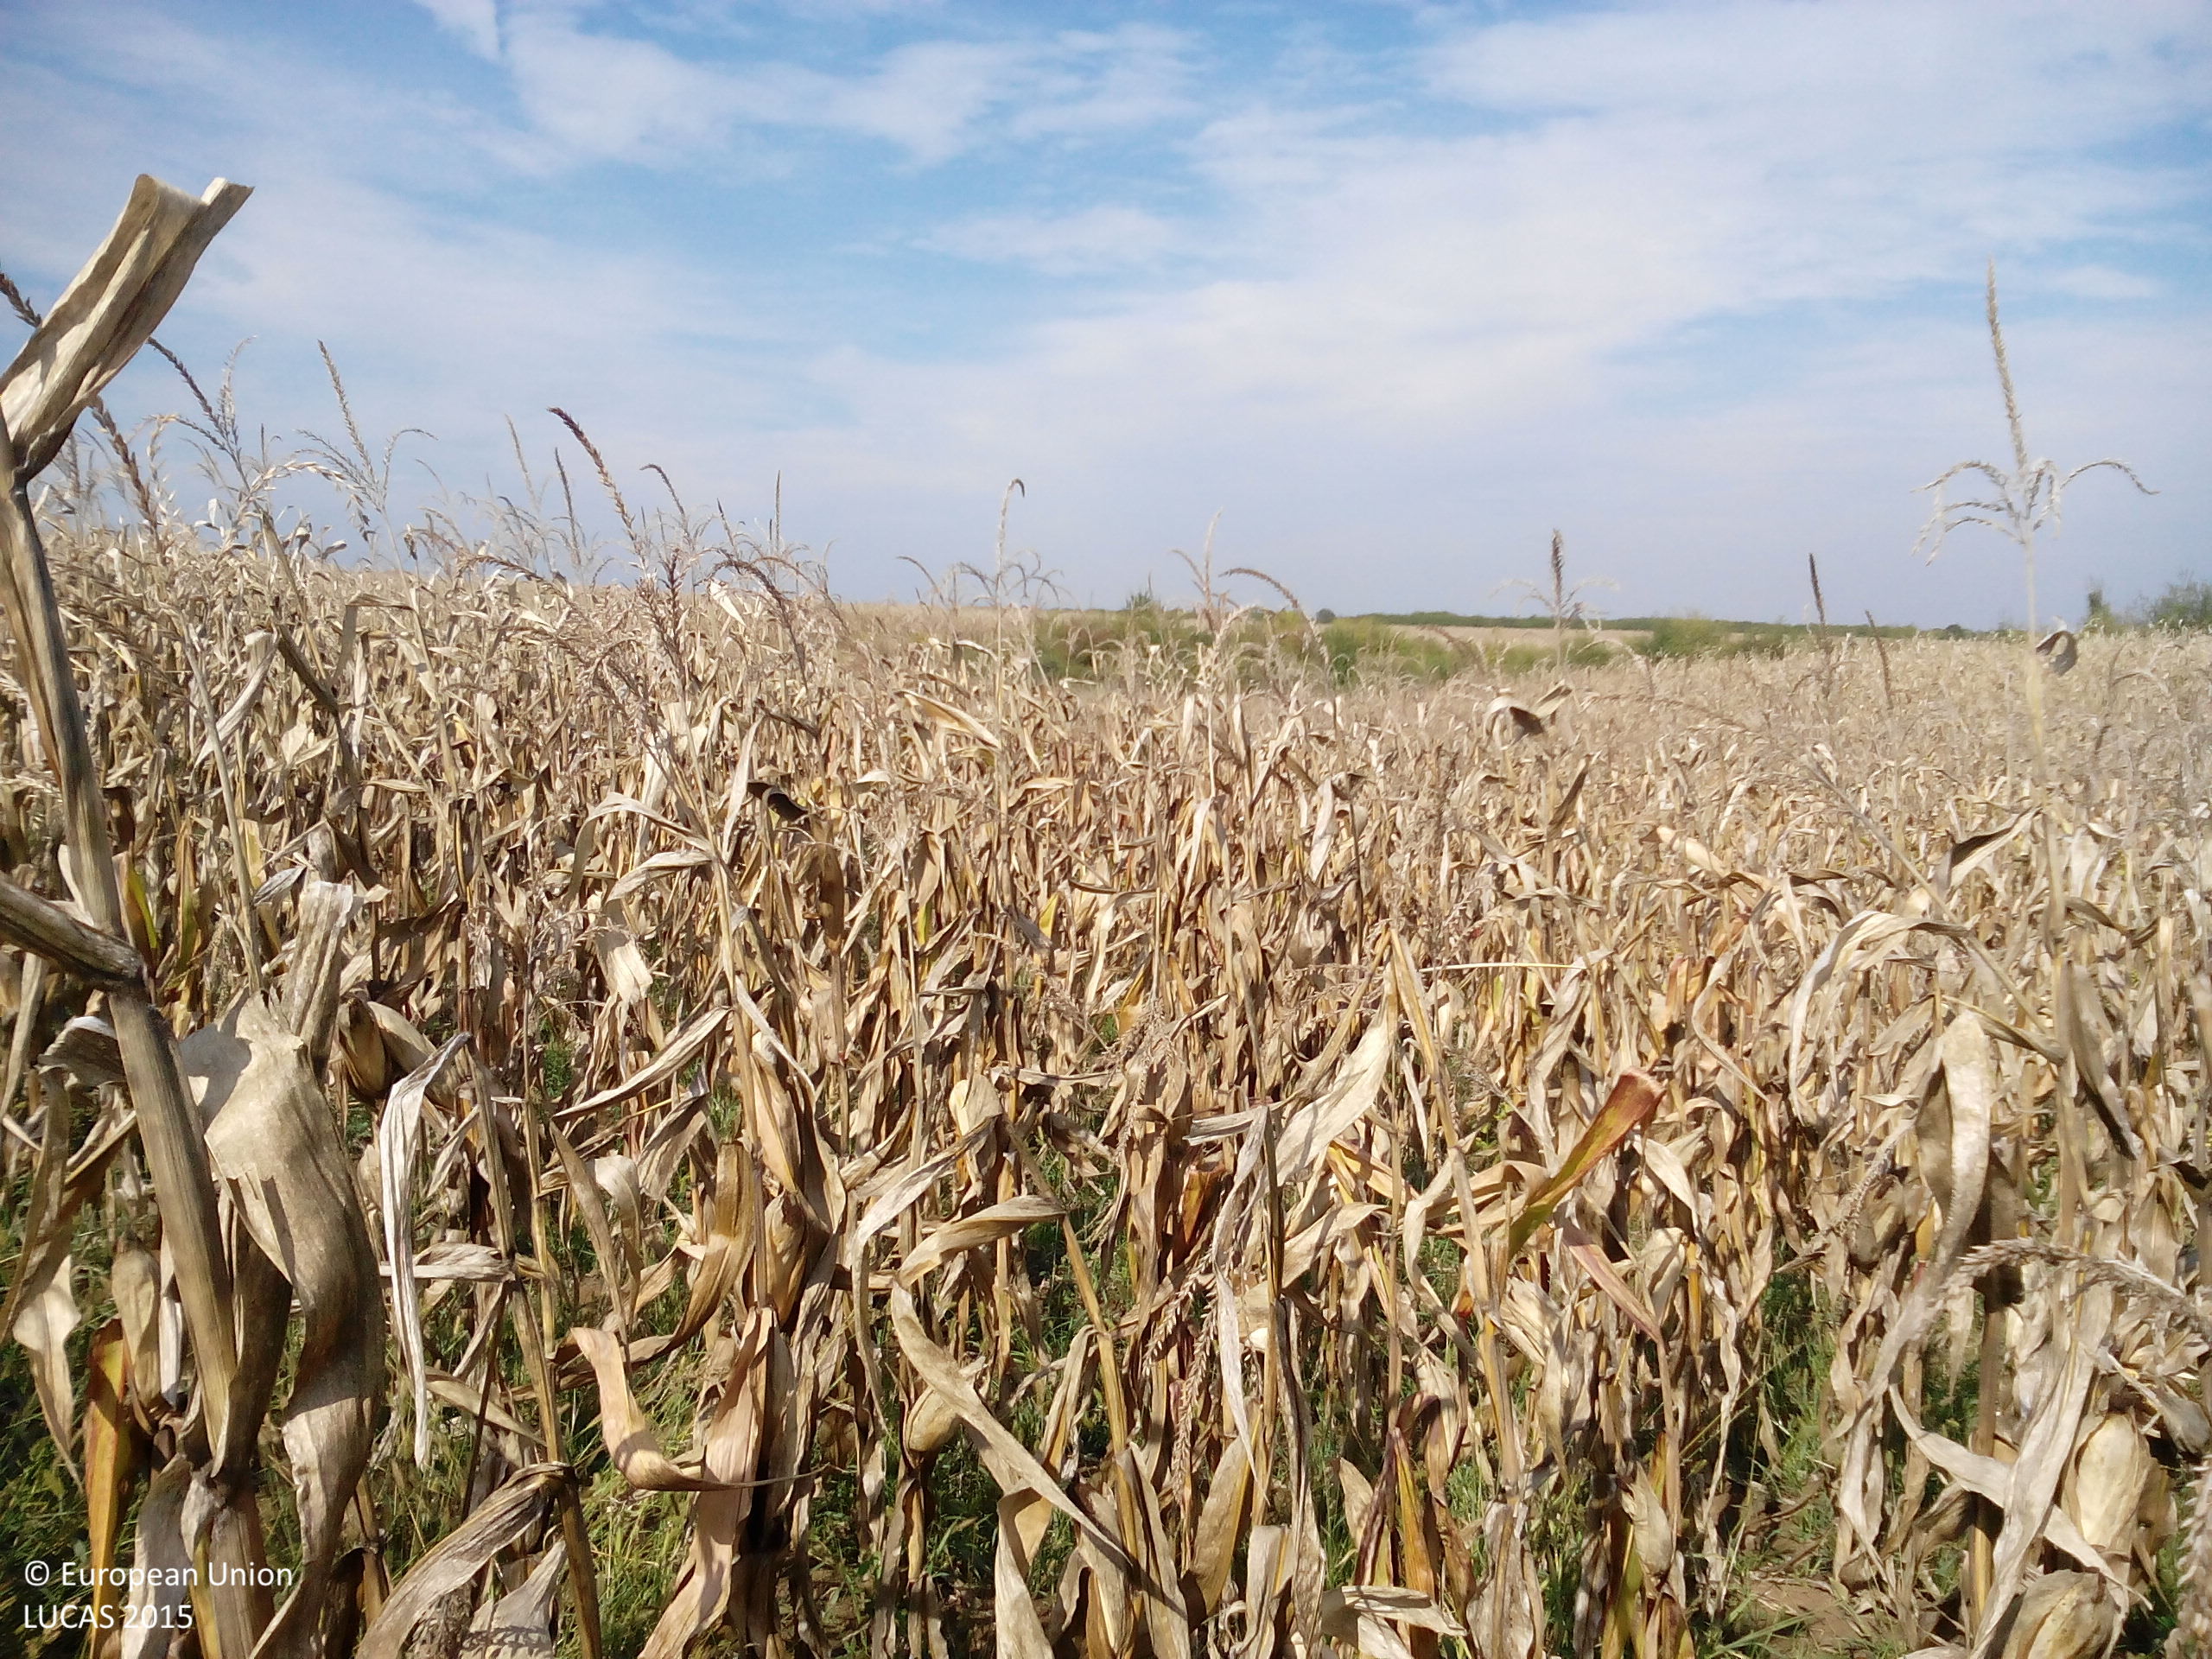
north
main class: Cropland
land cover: Maize
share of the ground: > 75 %
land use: Agriculture (excluding fallow land and kitchen gardens)
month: October
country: BG
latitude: 43.3485
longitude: 23.6781
